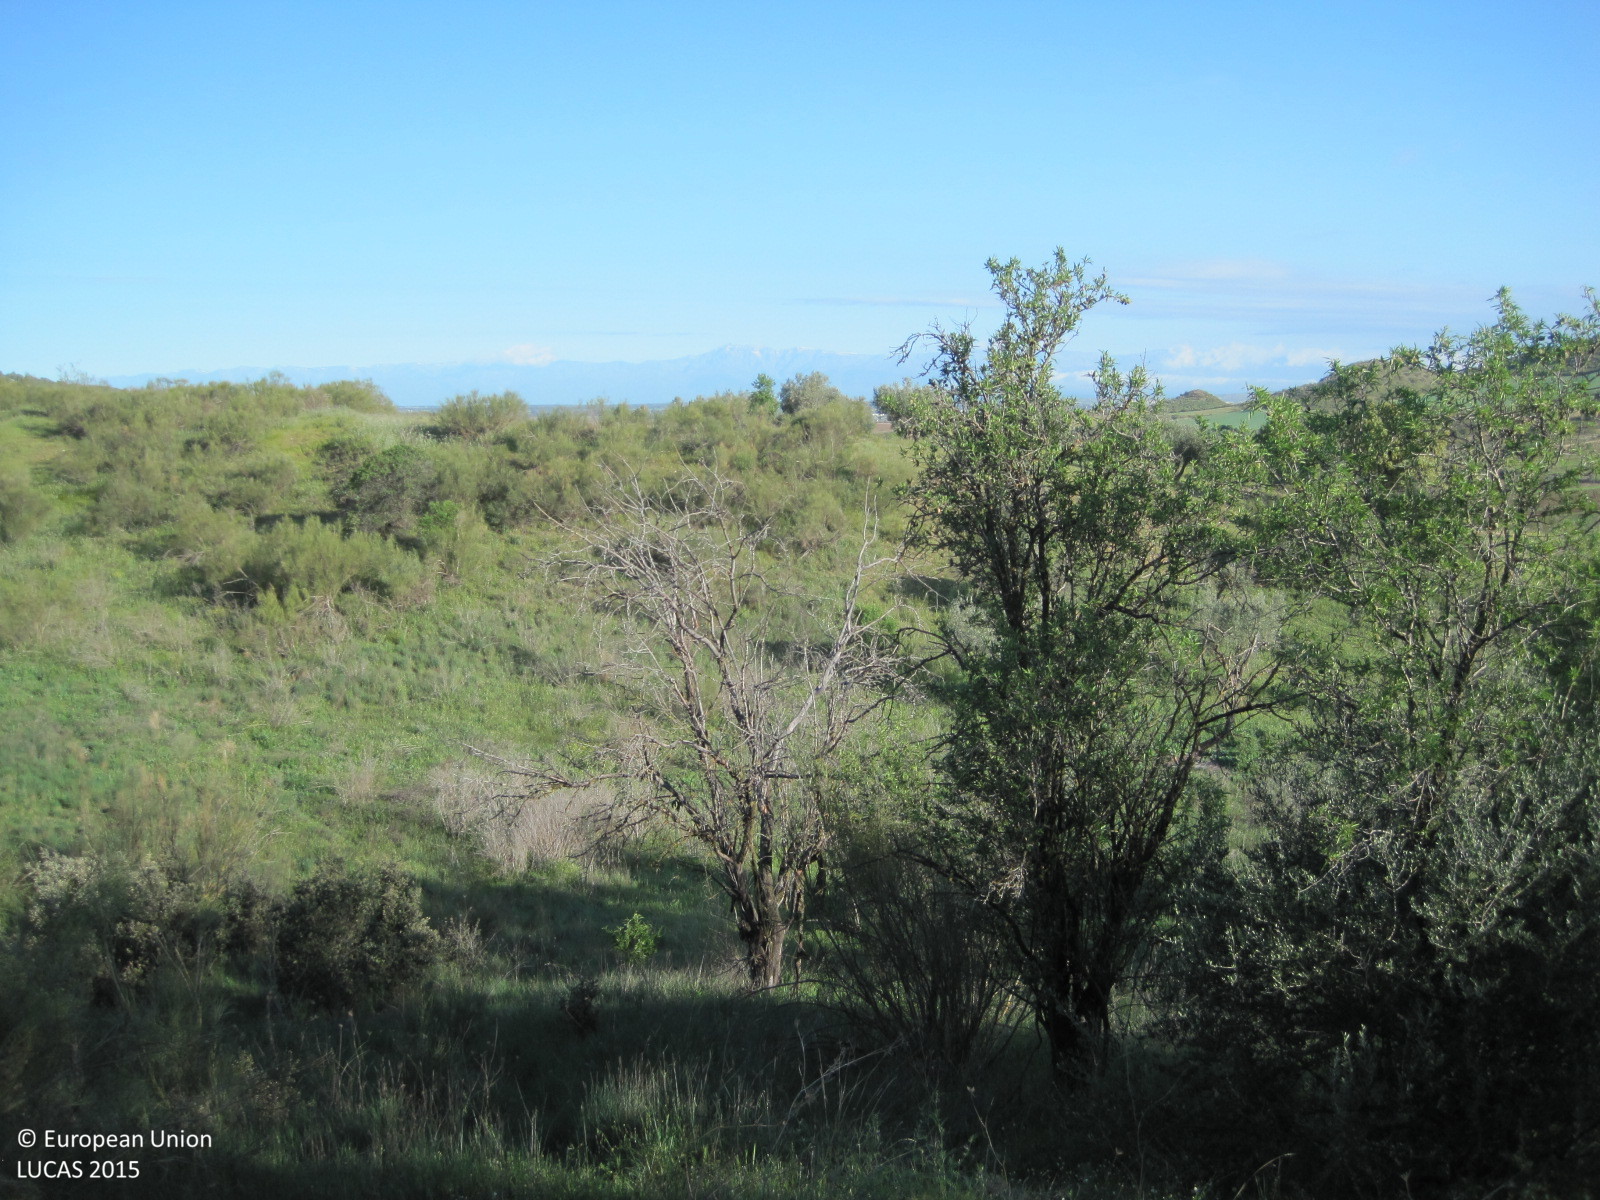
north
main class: Woodland
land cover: Broadleaved woodland
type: thermophilous deciduous forest
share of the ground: 10 - 25 %
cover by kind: herbaceous plants 50 %, shrubs 35 %, broadleaved forest trees 15 %
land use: Agriculture (excluding fallow land and kitchen gardens)
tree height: < 5 m
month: April
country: ES
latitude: 39.8563
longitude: -4.9039
